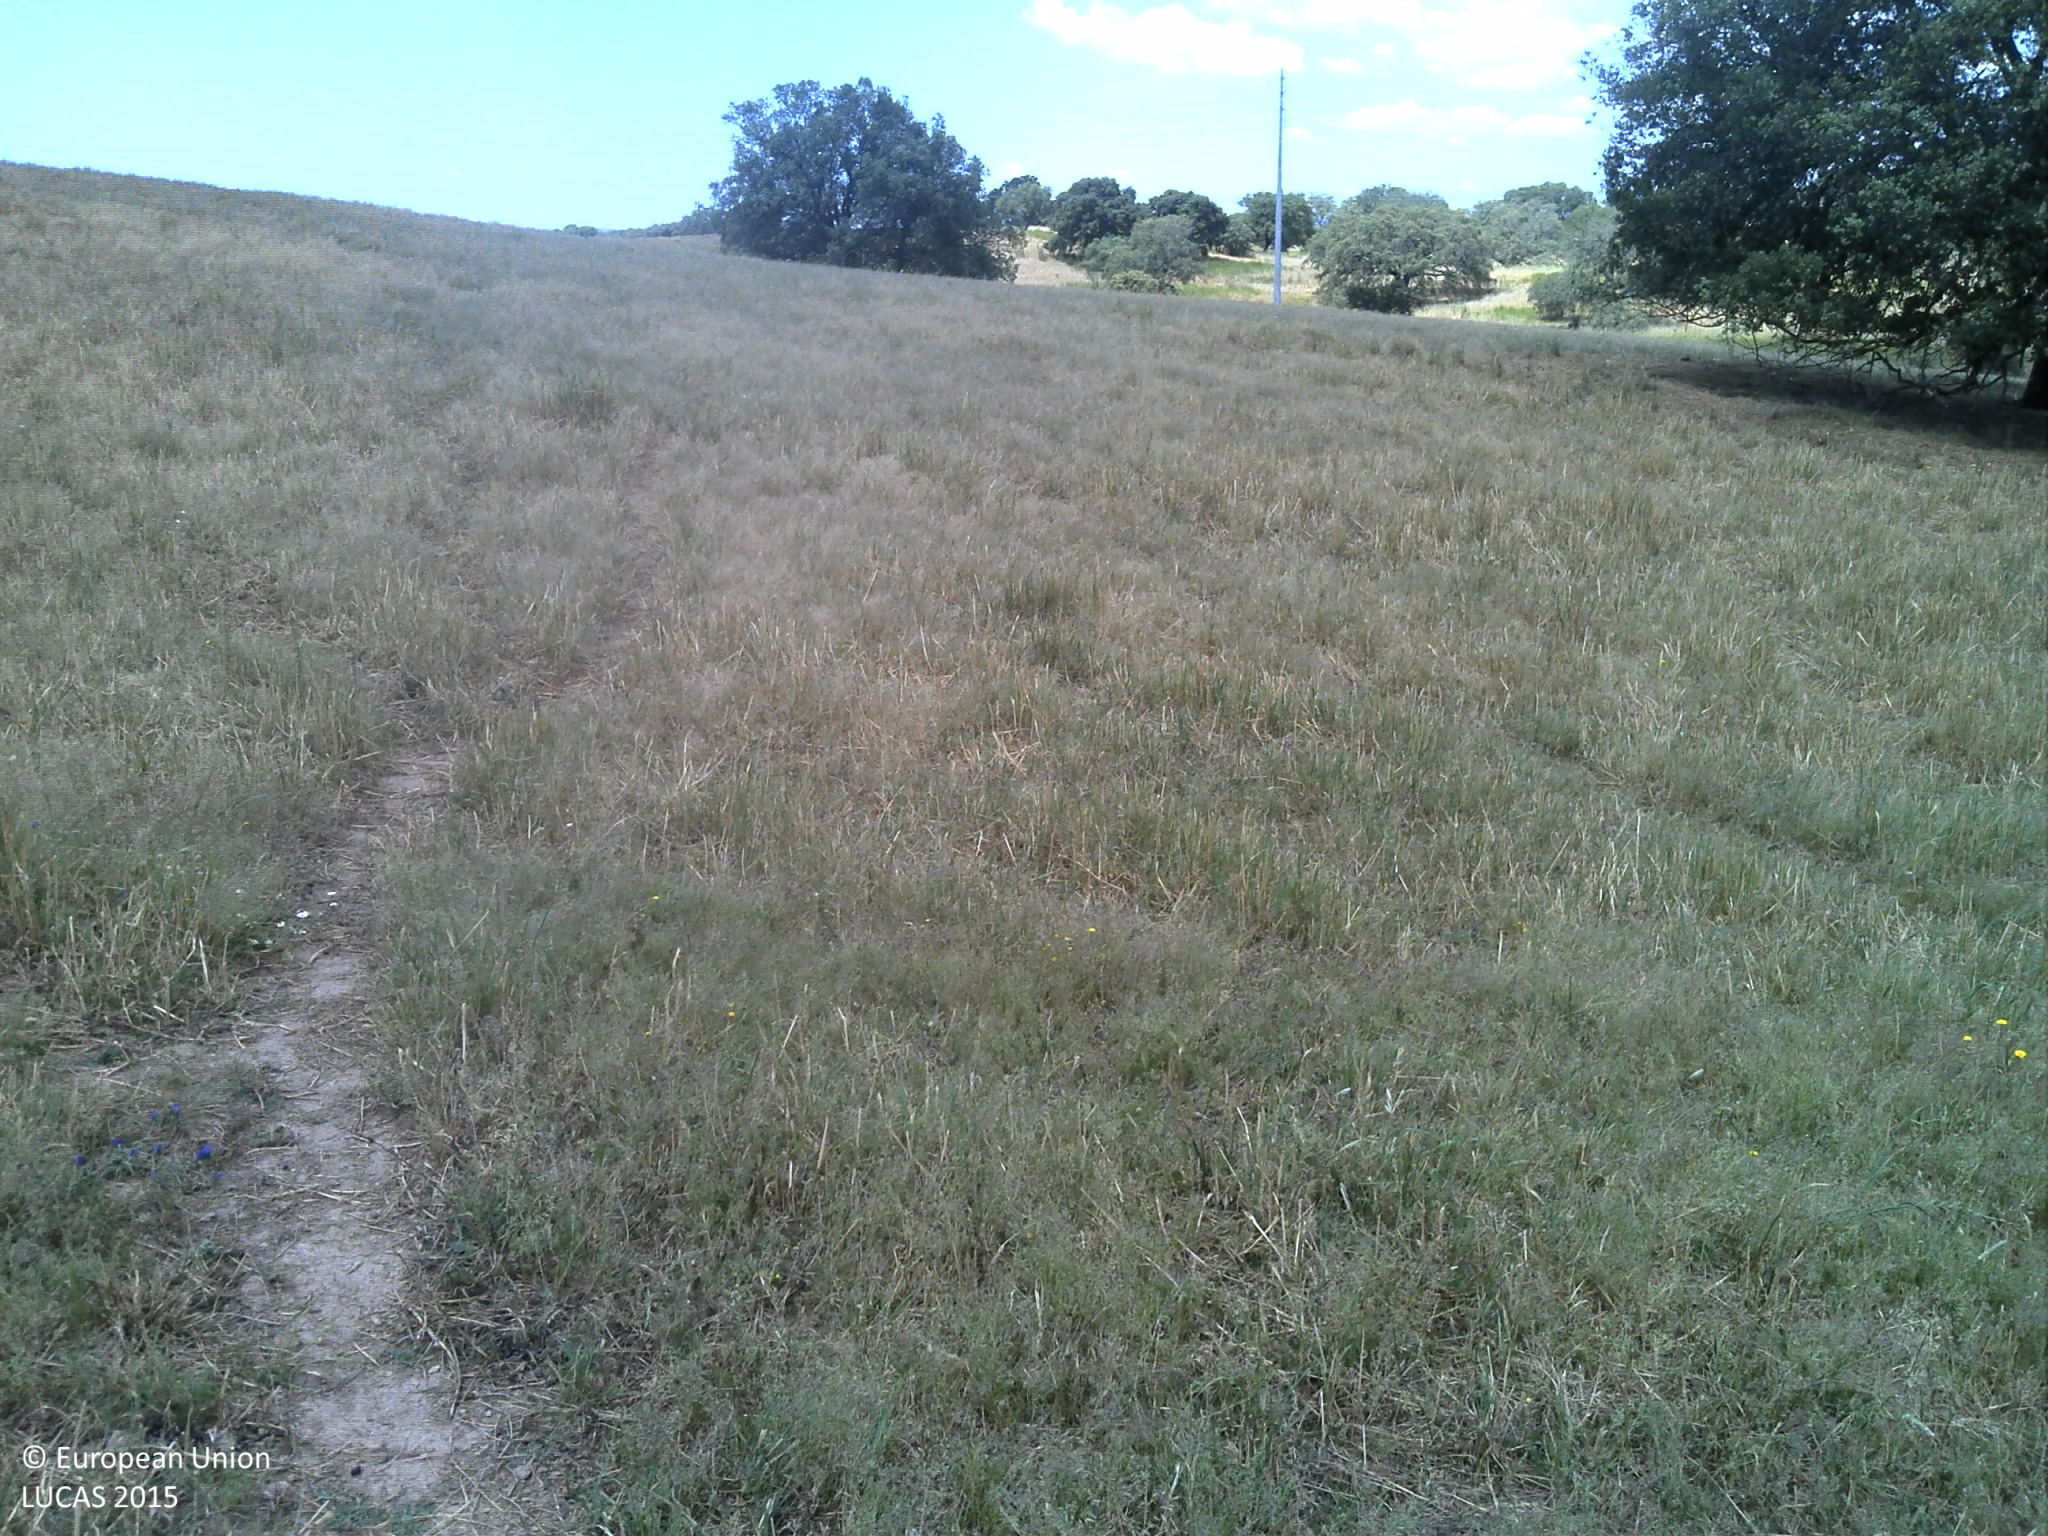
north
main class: Grassland
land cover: Grassland without tree/shrub cover
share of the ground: 50 - 75 %
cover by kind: herbaceous plants 70 %, unconsolidated bare surface 30 %
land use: Agriculture (excluding fallow land and kitchen gardens)
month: May
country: PT
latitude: 37.9950
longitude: -8.5717
